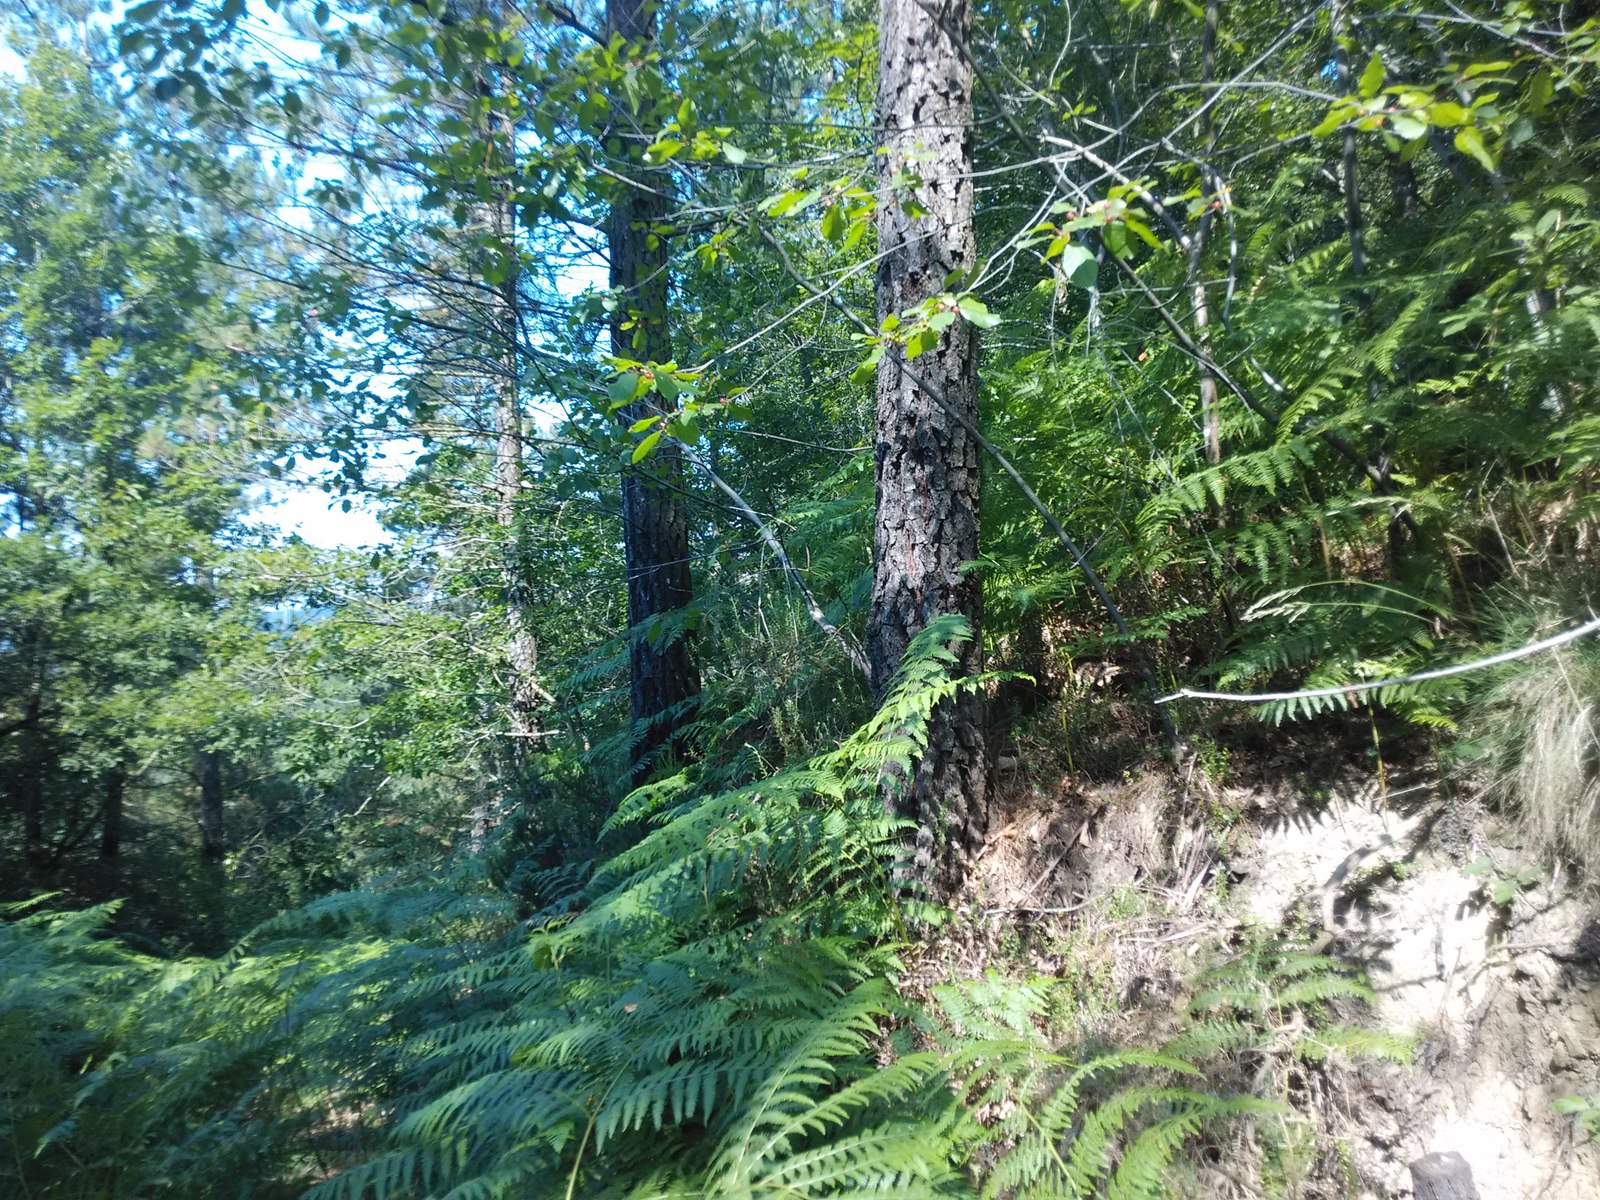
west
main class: Woodland
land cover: Other mixed woodland
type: broadleaved evergreen forest
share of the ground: > 75 %
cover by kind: coniferous forest trees 45 %, broadleaved forest trees 40 %, shrubs 15 %
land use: Forestry
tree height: > 5 m
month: June
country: ES
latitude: 43.0549
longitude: -2.4136
